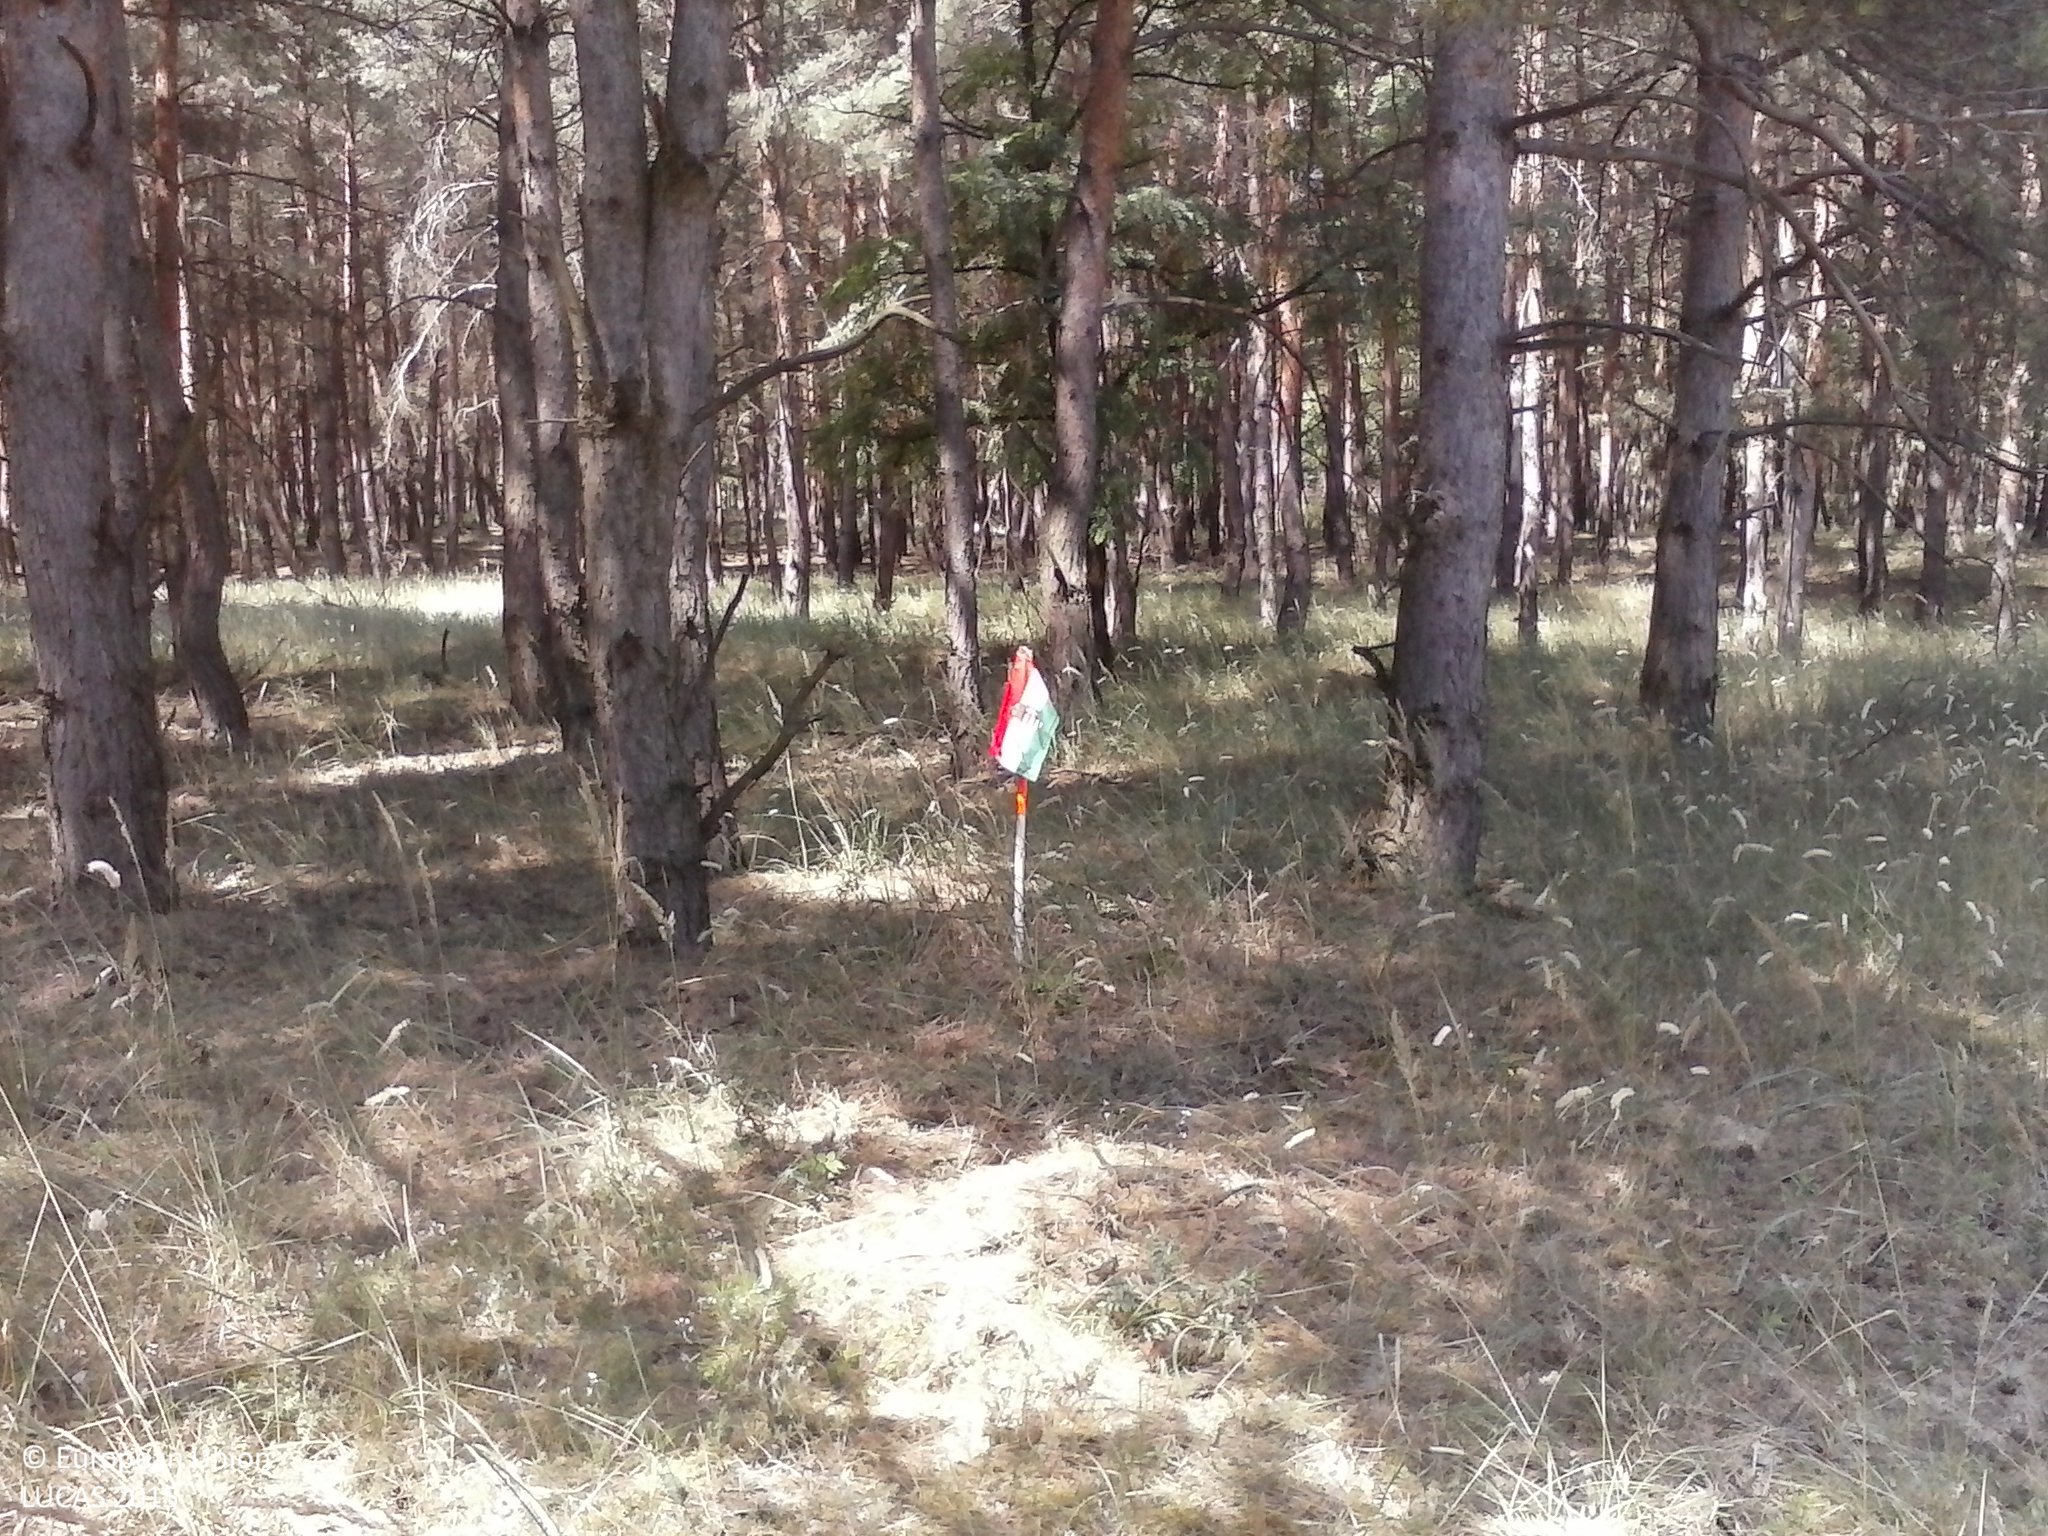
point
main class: Woodland
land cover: Pine dominated coniferous woodland
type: hemiboreal forest and nemoral coniferous forest and mixed broadleaved-coniferous forest
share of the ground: > 75 %
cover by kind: coniferous forest trees 90 %, shrubs 5 %, herbaceous plants 5 %
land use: Forestry
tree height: > 5 m
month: July
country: HU
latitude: 46.2804
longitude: 19.6082
